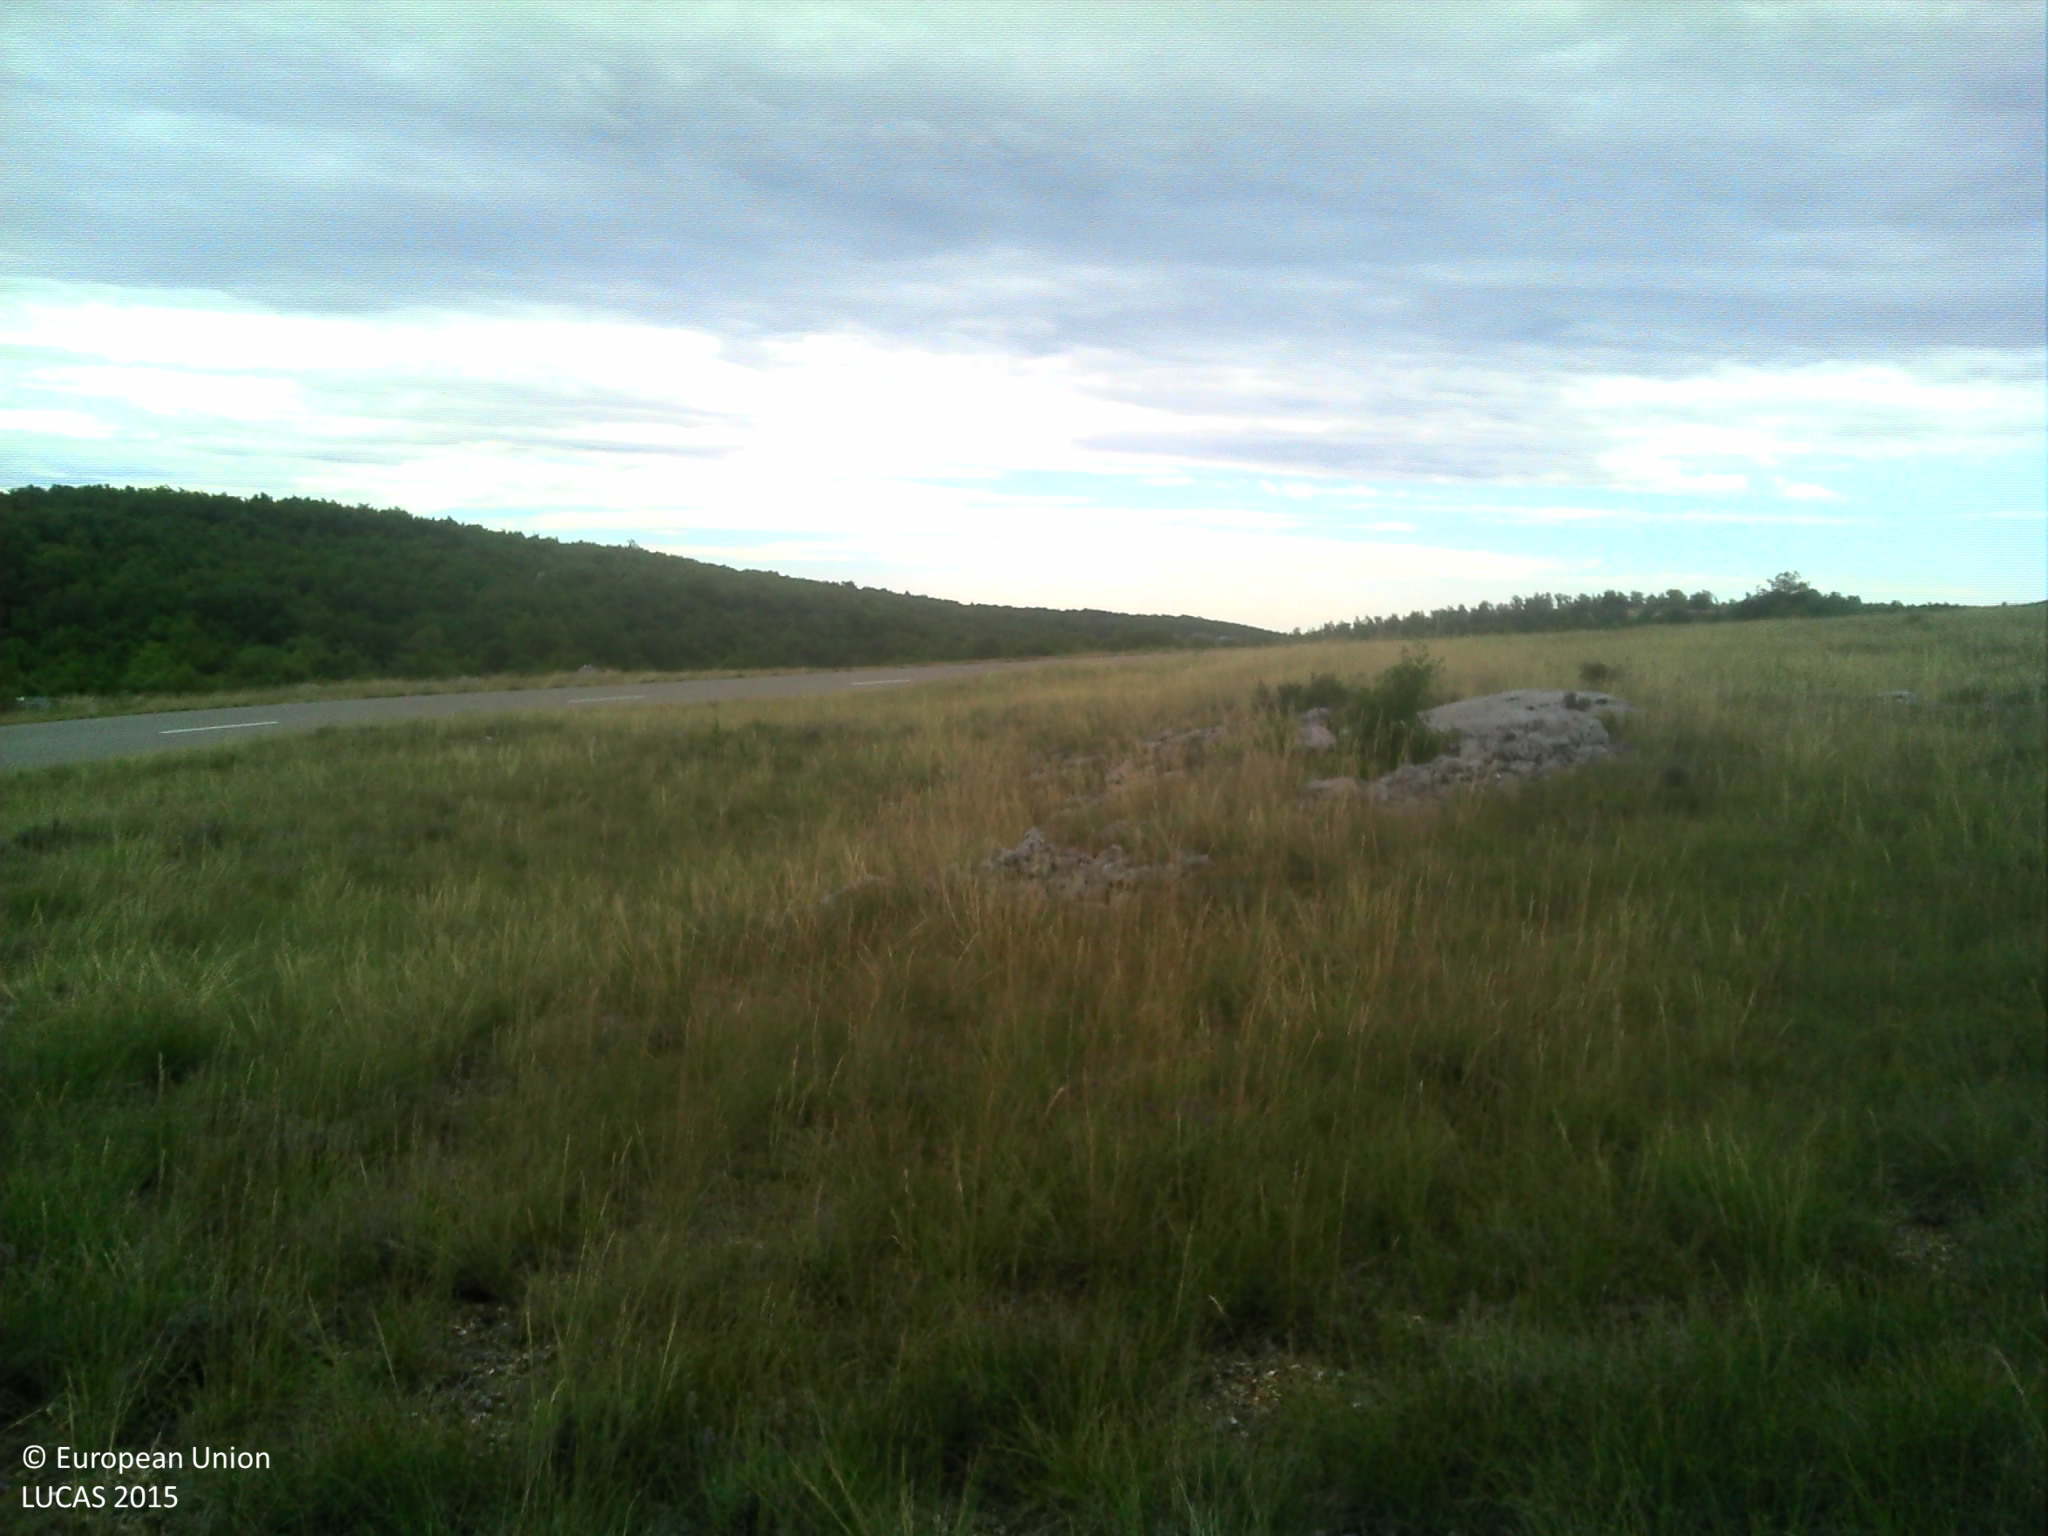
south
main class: Grassland
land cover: Grassland with sparse tree/shrub cover
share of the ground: > 75 %
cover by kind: herbaceous plants 75 %, consolidated bare surface 15 %, coniferous forest trees 5 %, shrubs 5 %
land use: Semi-natural and natural areas not in use
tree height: < 5 m
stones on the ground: 25 - 50 %
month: July
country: FR
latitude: 44.0014
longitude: 5.5311
